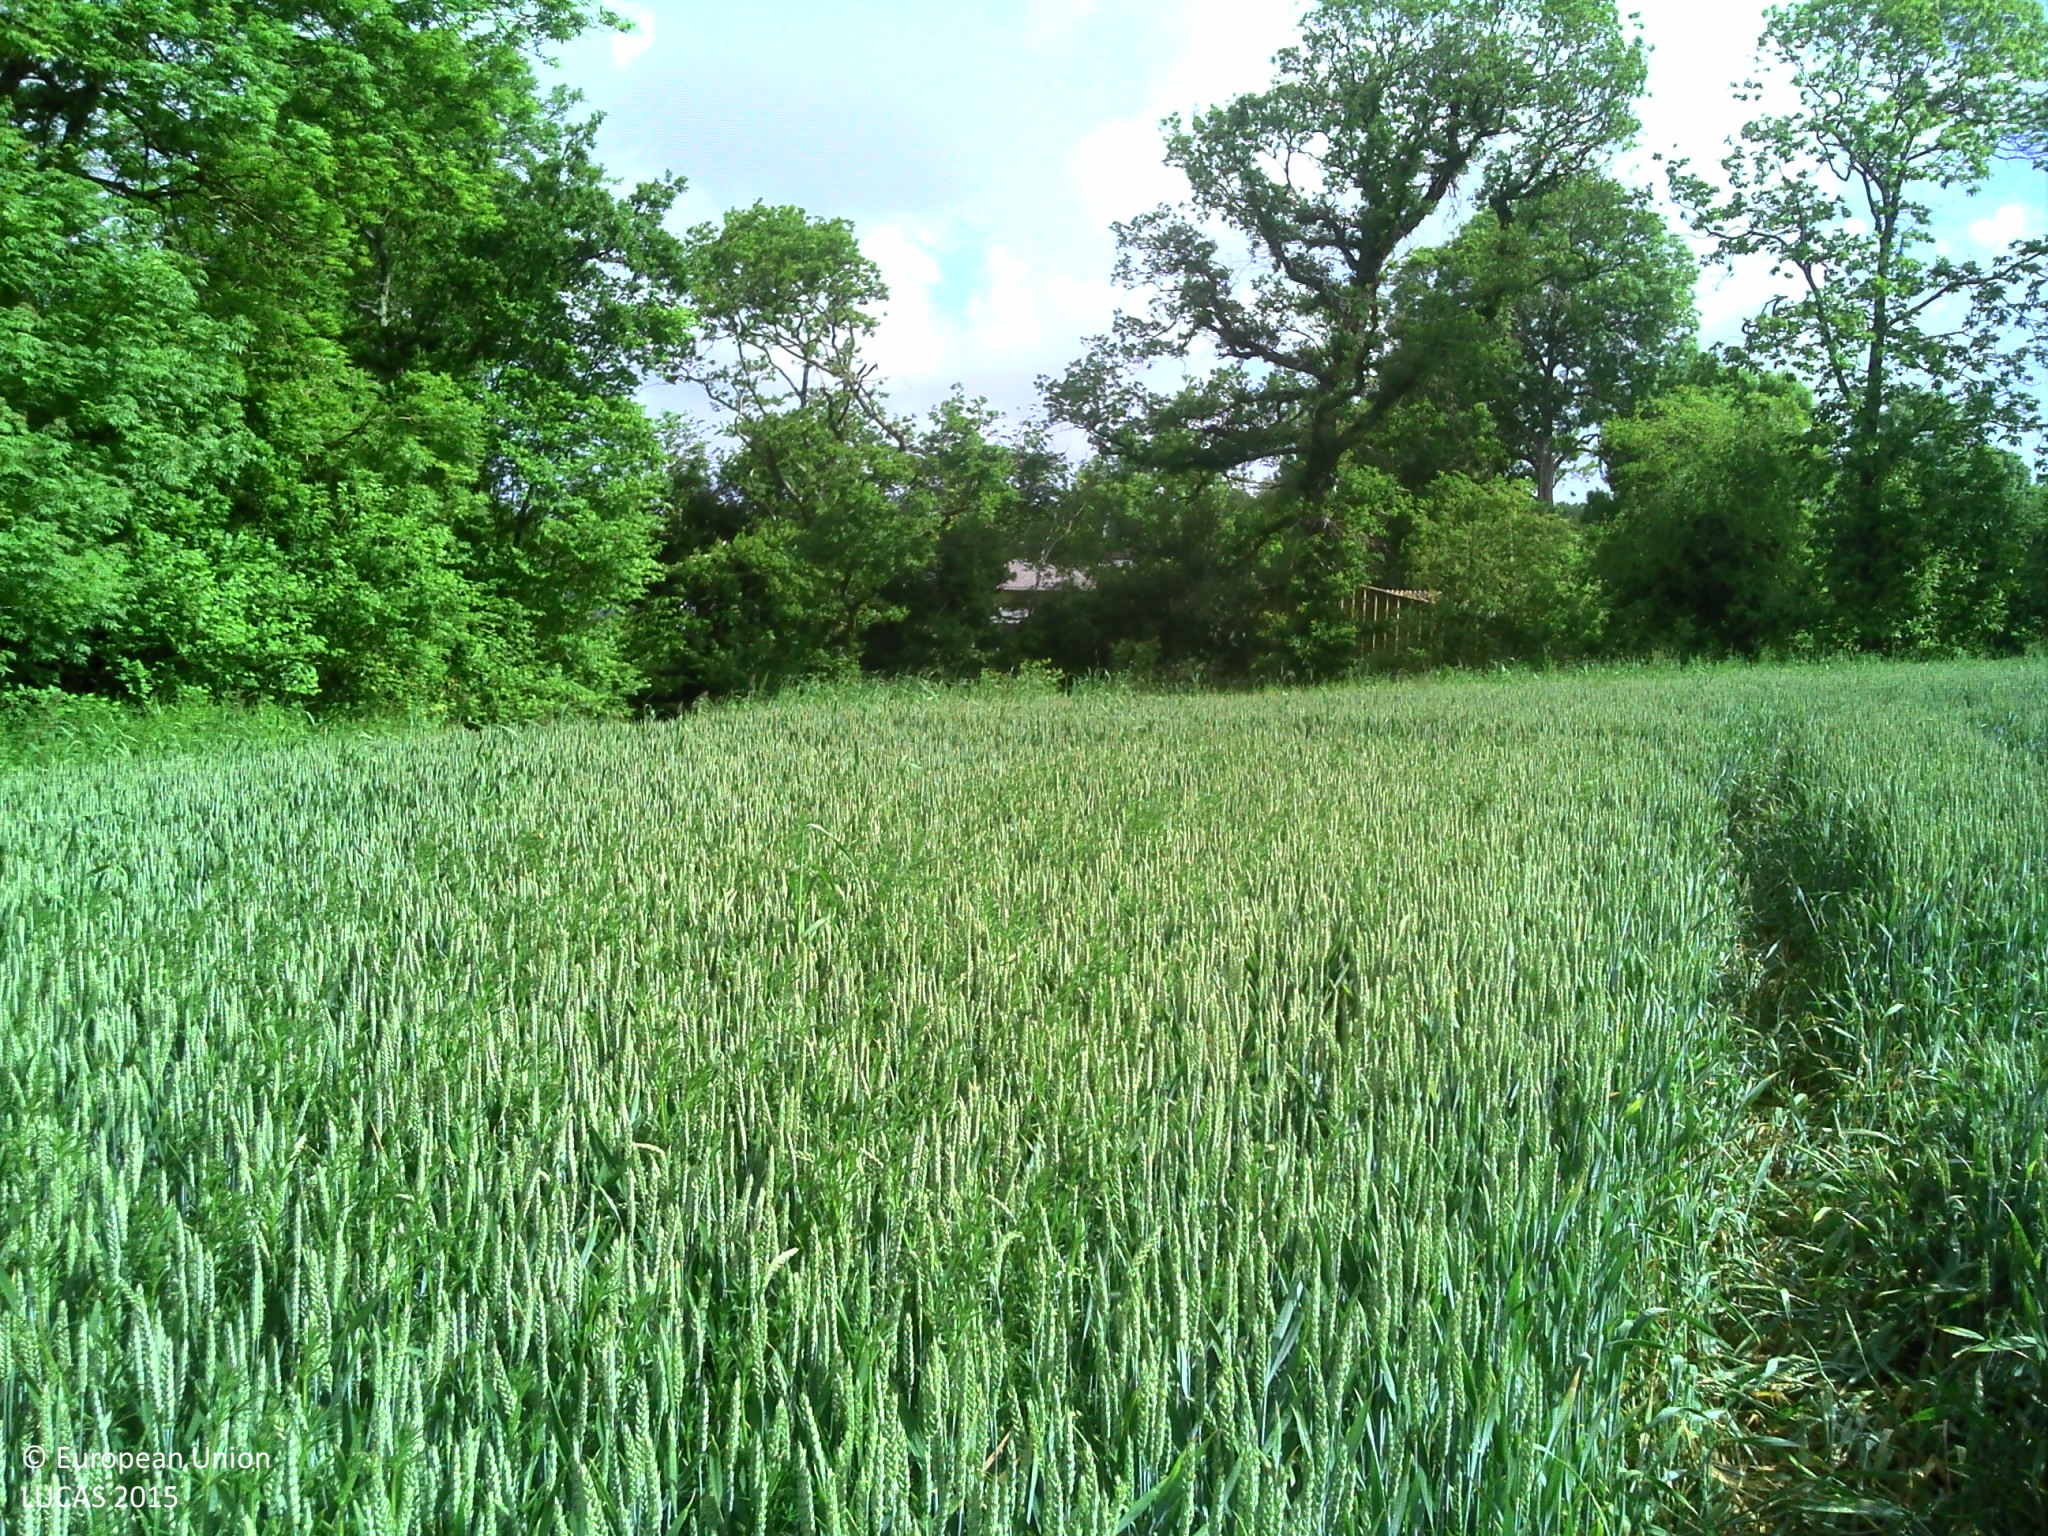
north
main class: Cropland
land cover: Common wheat
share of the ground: > 75 %
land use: Agriculture (excluding fallow land and kitchen gardens)
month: June
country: FR
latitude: 49.5577
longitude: -1.7343
